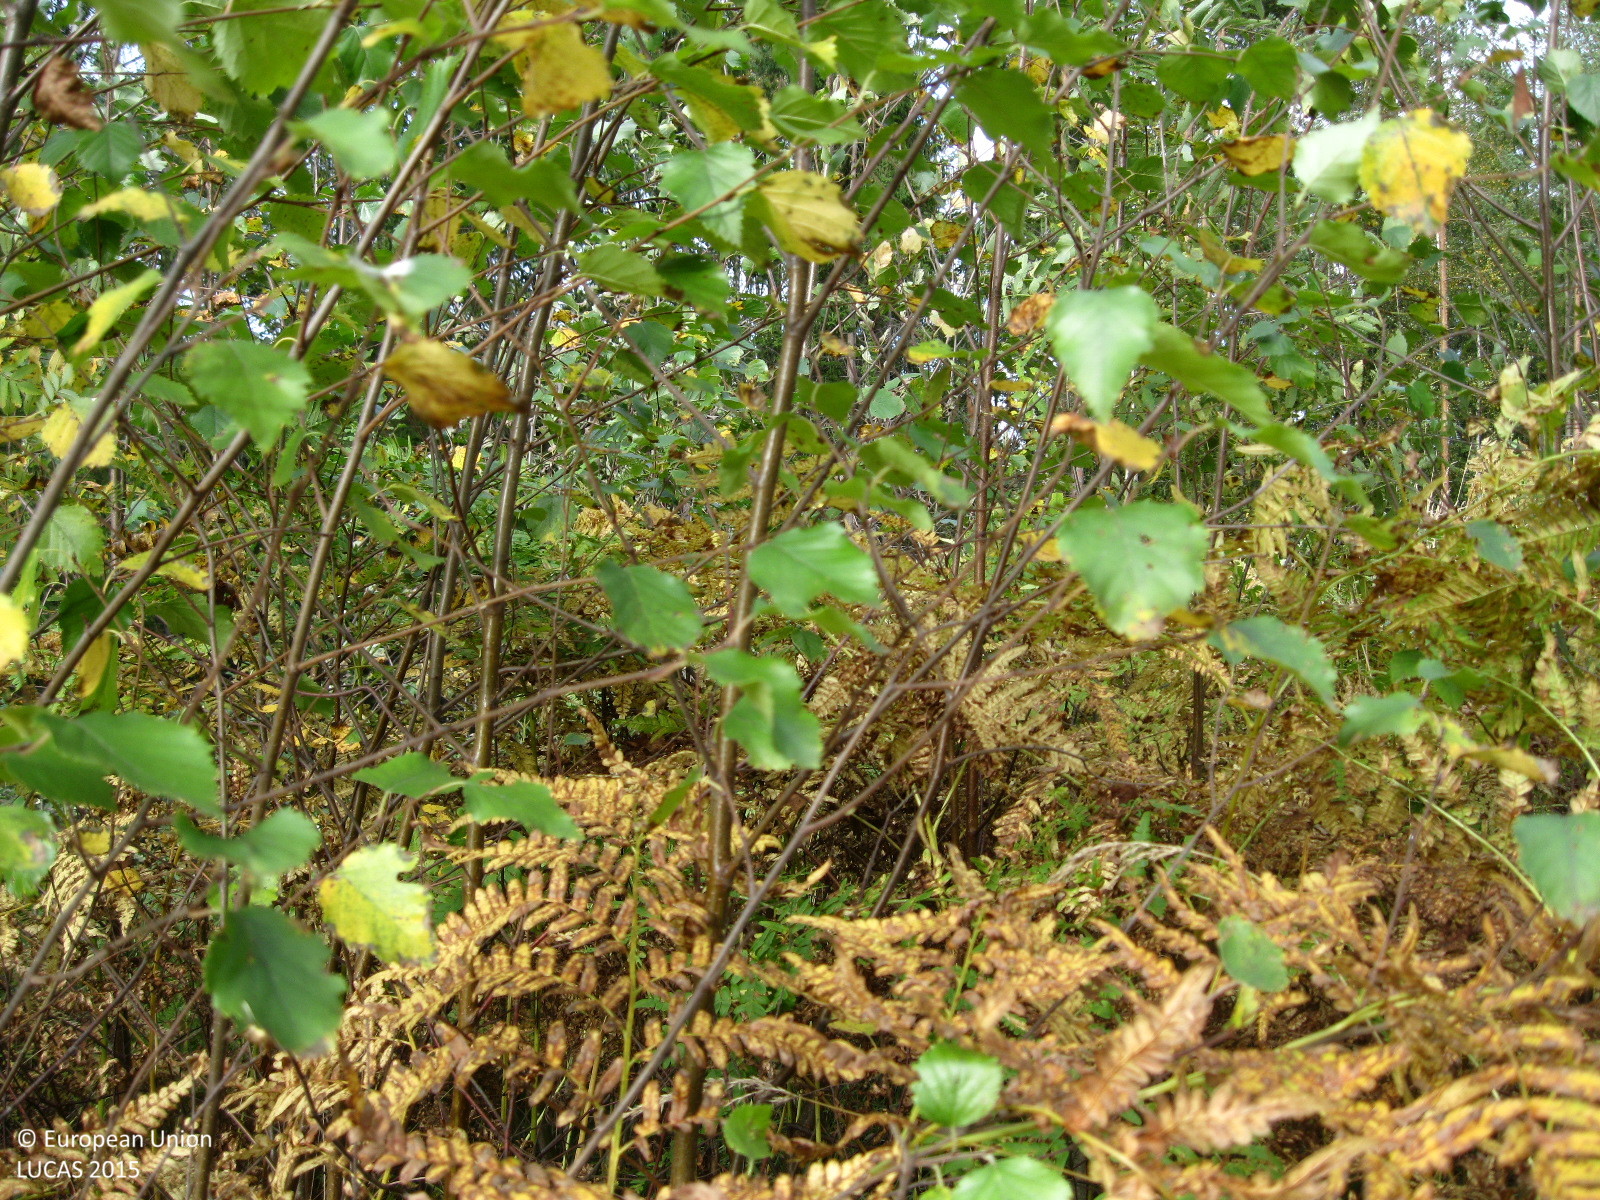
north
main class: Woodland
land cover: Broadleaved woodland
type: boreal forest
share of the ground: 25 - 50 %
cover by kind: herbaceous plants 60 %, broadleaved forest trees 40 %
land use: Electricity, gas and thermal power distribution
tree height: < 5 m
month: September
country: FI
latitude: 60.7134
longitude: 24.8277
